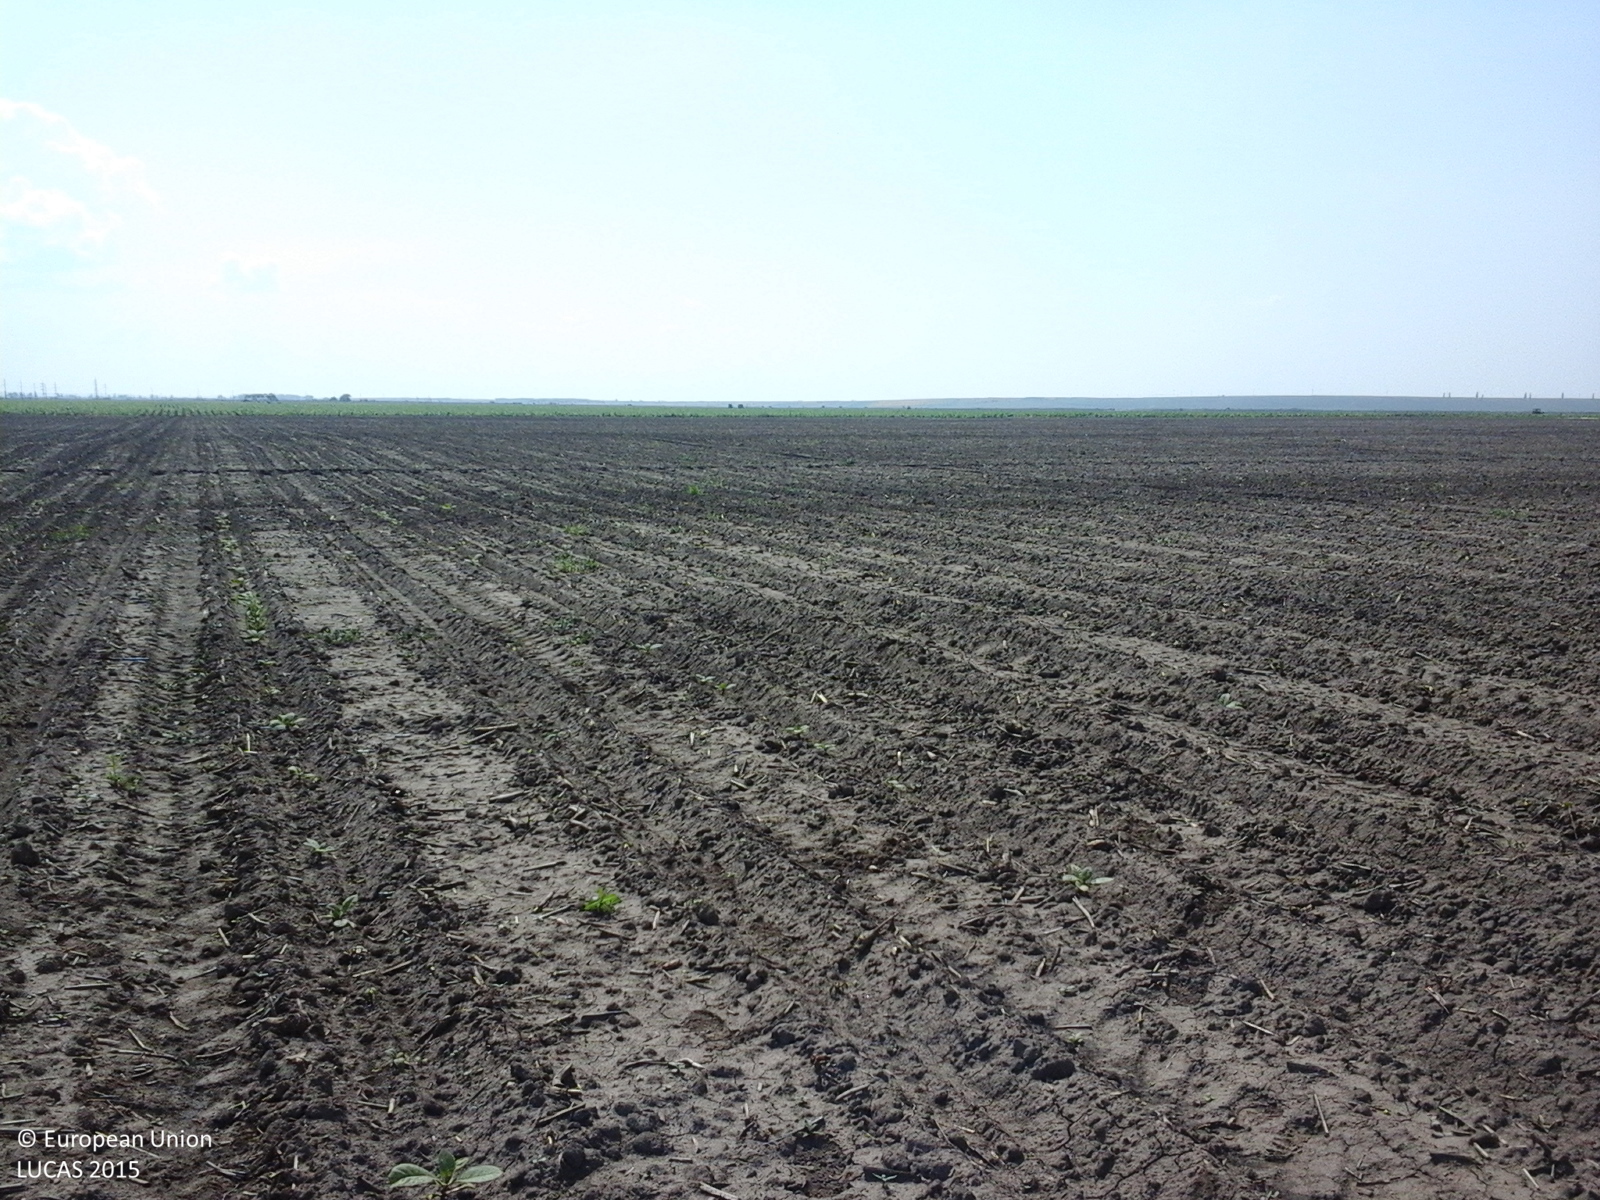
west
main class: Cropland
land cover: Tobacco
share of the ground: < 10 %
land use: Agriculture (excluding fallow land and kitchen gardens)
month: July
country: RO
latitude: 43.6837
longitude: 25.4271
